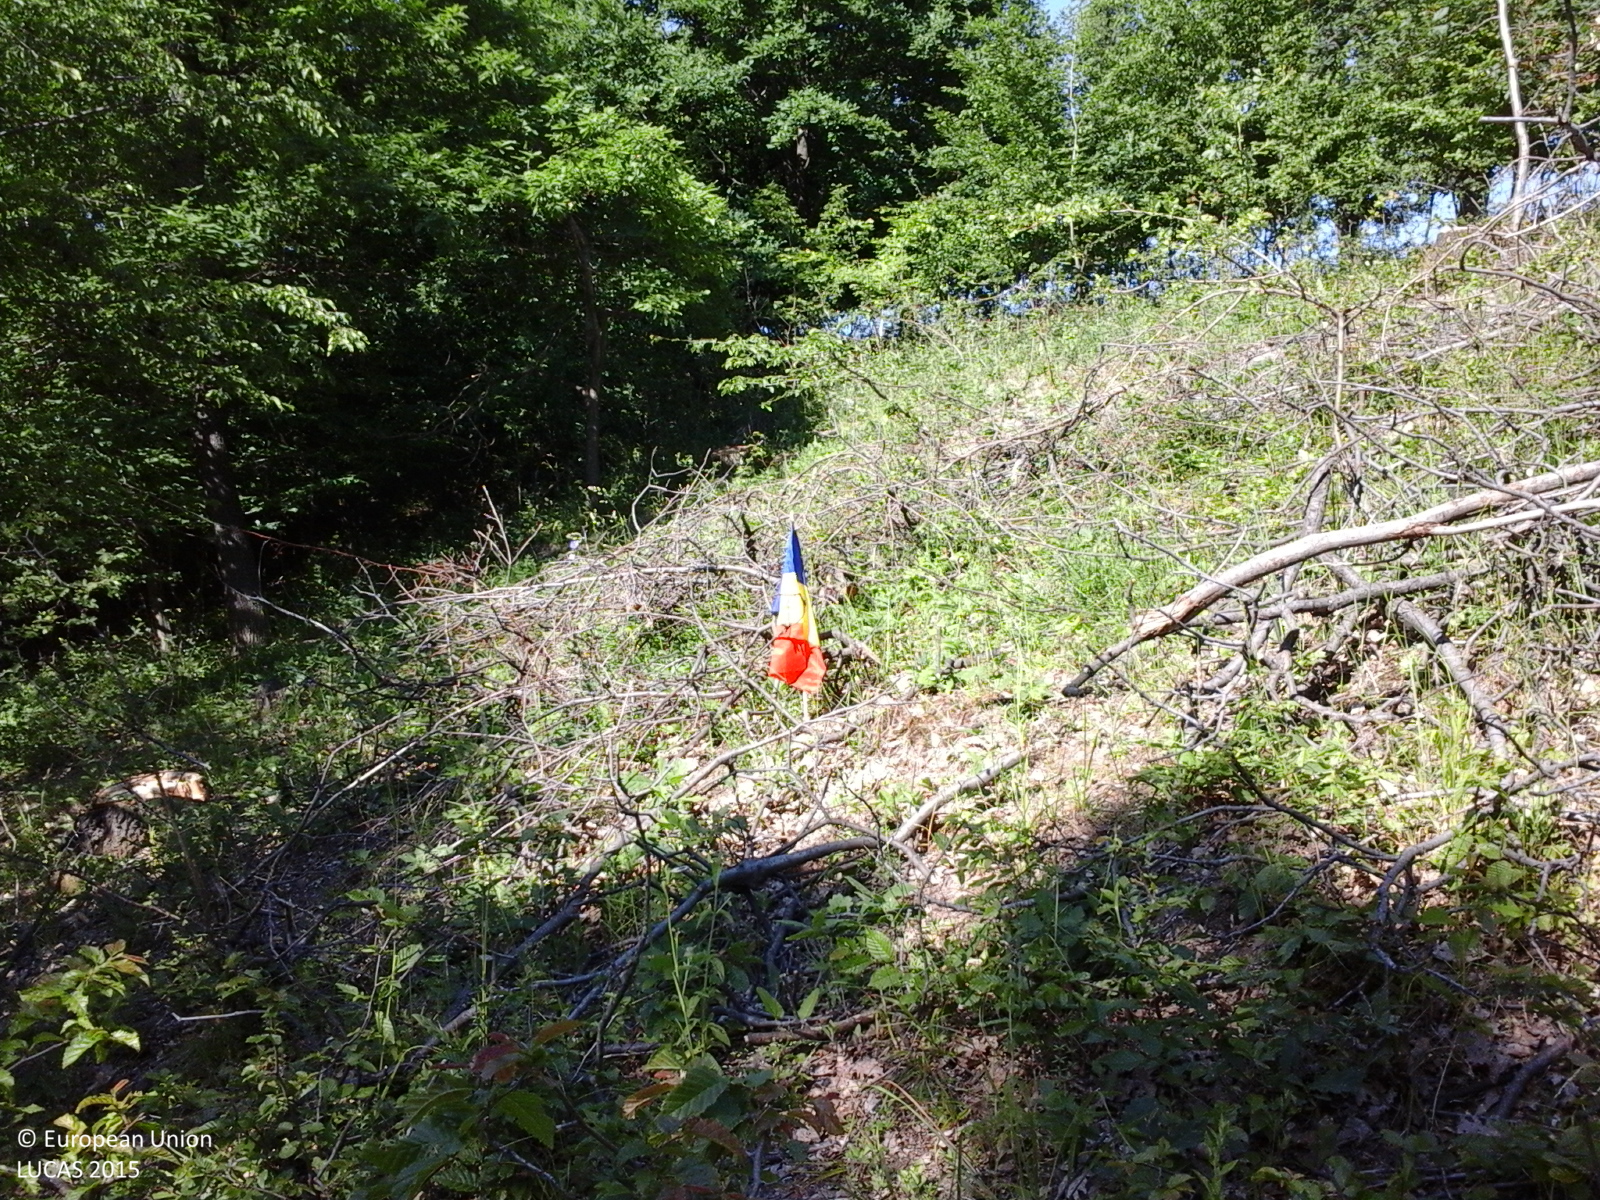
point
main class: Woodland
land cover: Broadleaved woodland
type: acidophilous oak and oak-birch forest
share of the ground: > 75 %
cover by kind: broadleaved forest trees 90 %, shrubs 10 %
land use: Forestry
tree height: > 5 m
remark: Clear cut
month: June
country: RO
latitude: 45.1297
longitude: 25.8073
